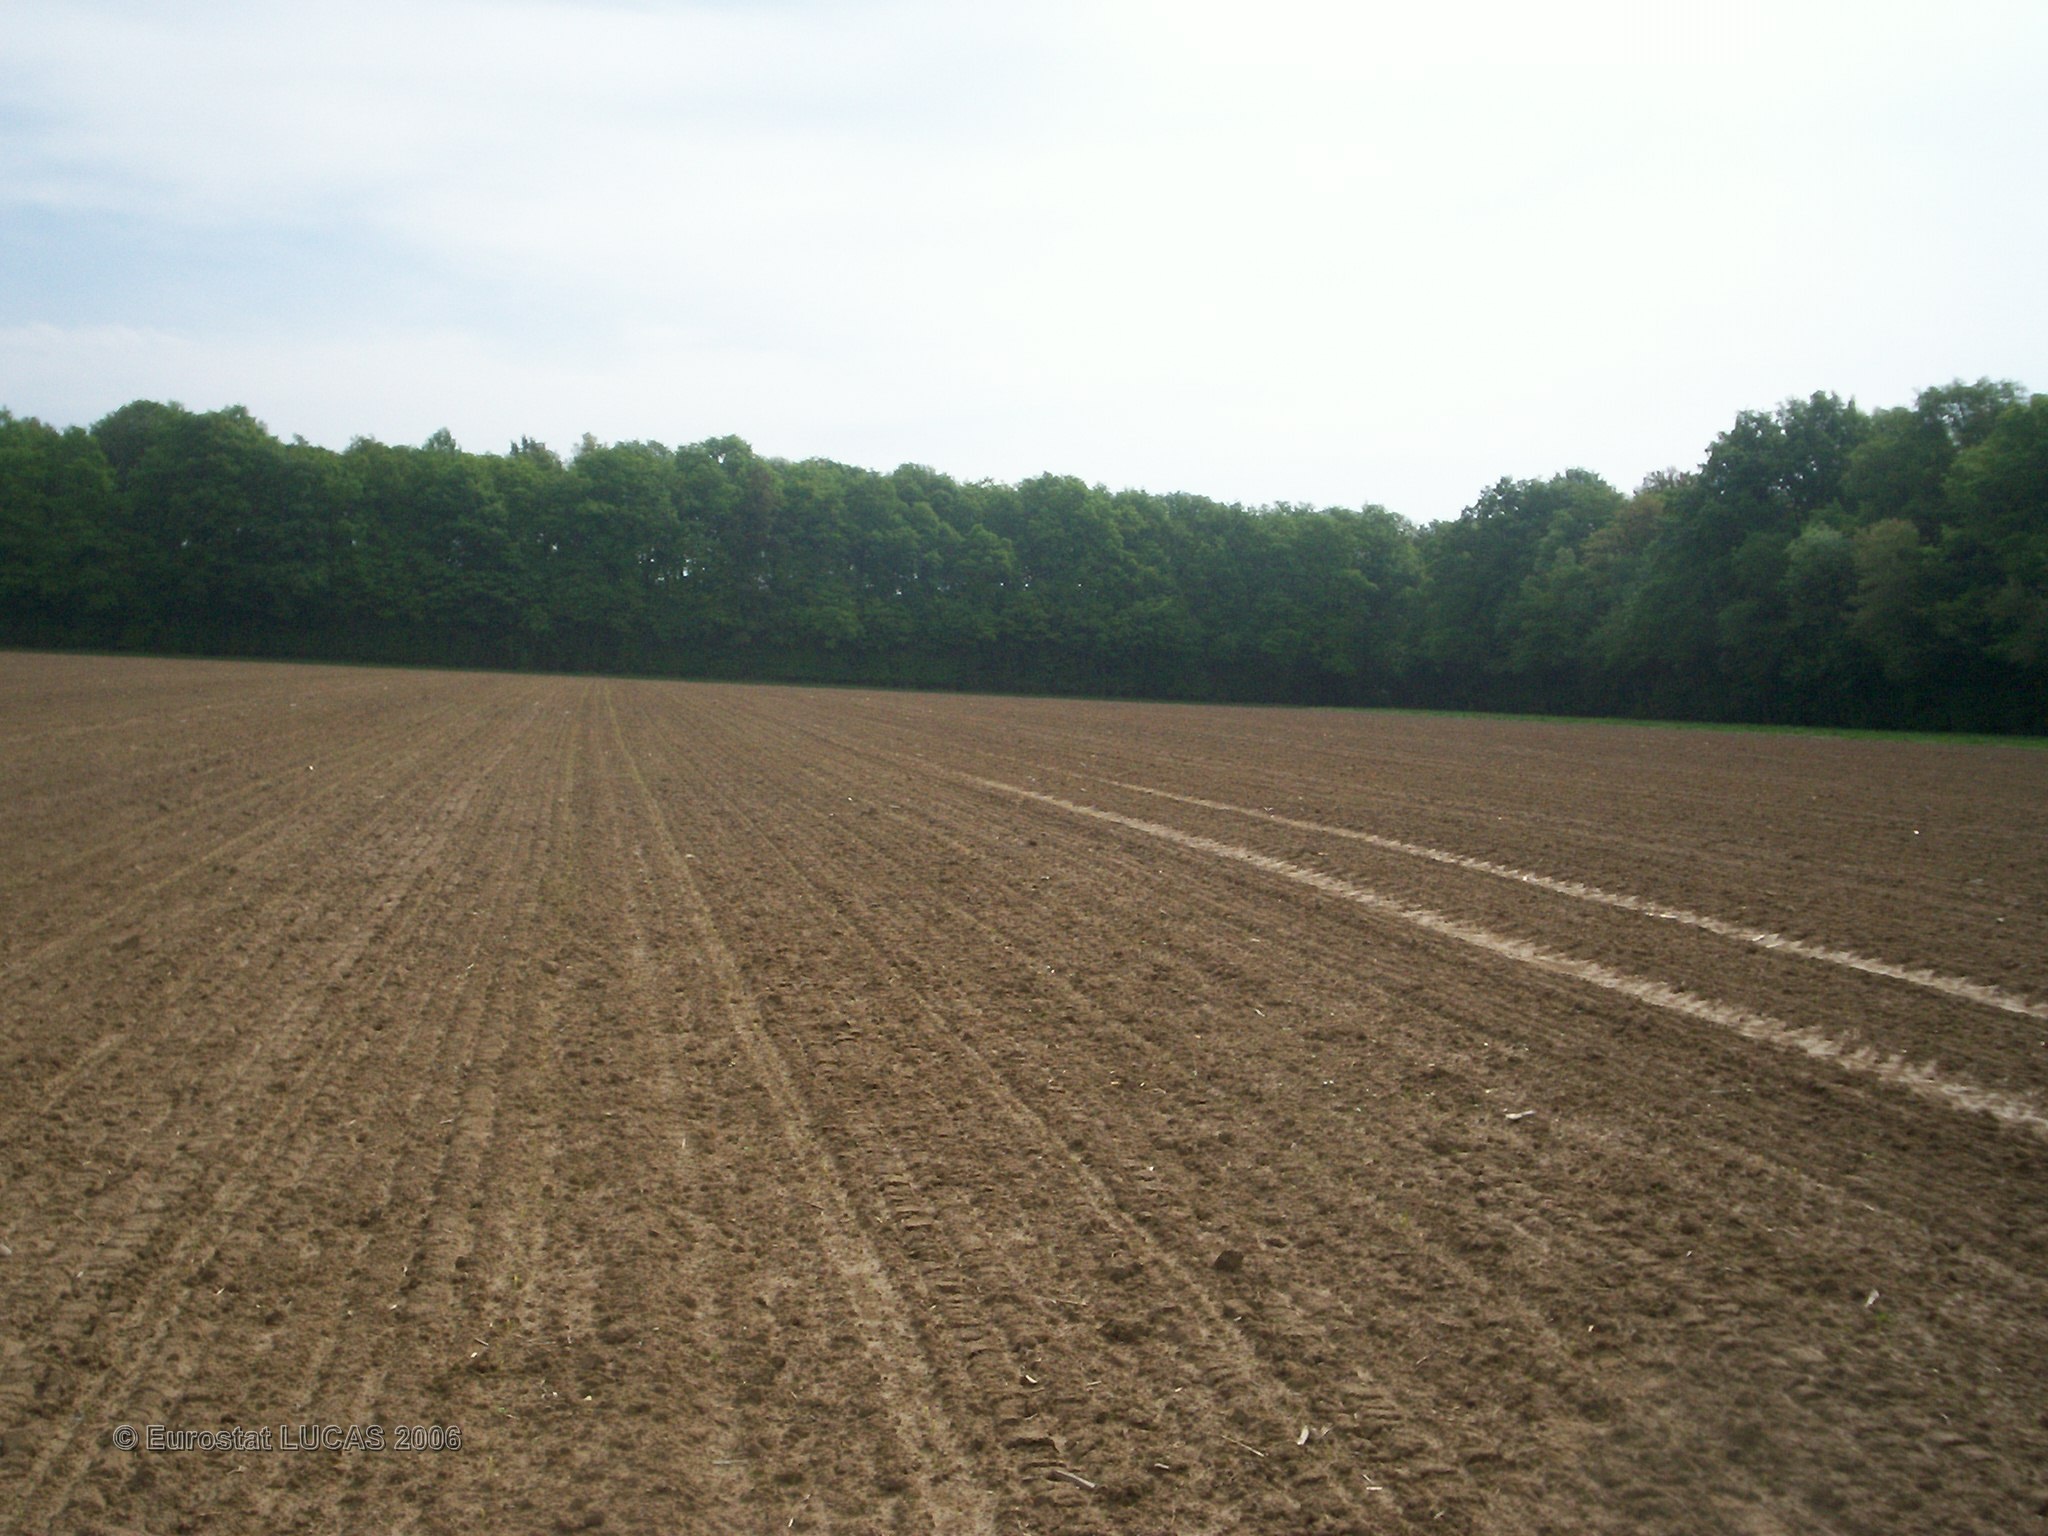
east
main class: Cropland
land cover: Maize
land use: Agriculture (excluding fallow land and kitchen gardens)
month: May
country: FR
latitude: 47.7671
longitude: 3.0153
